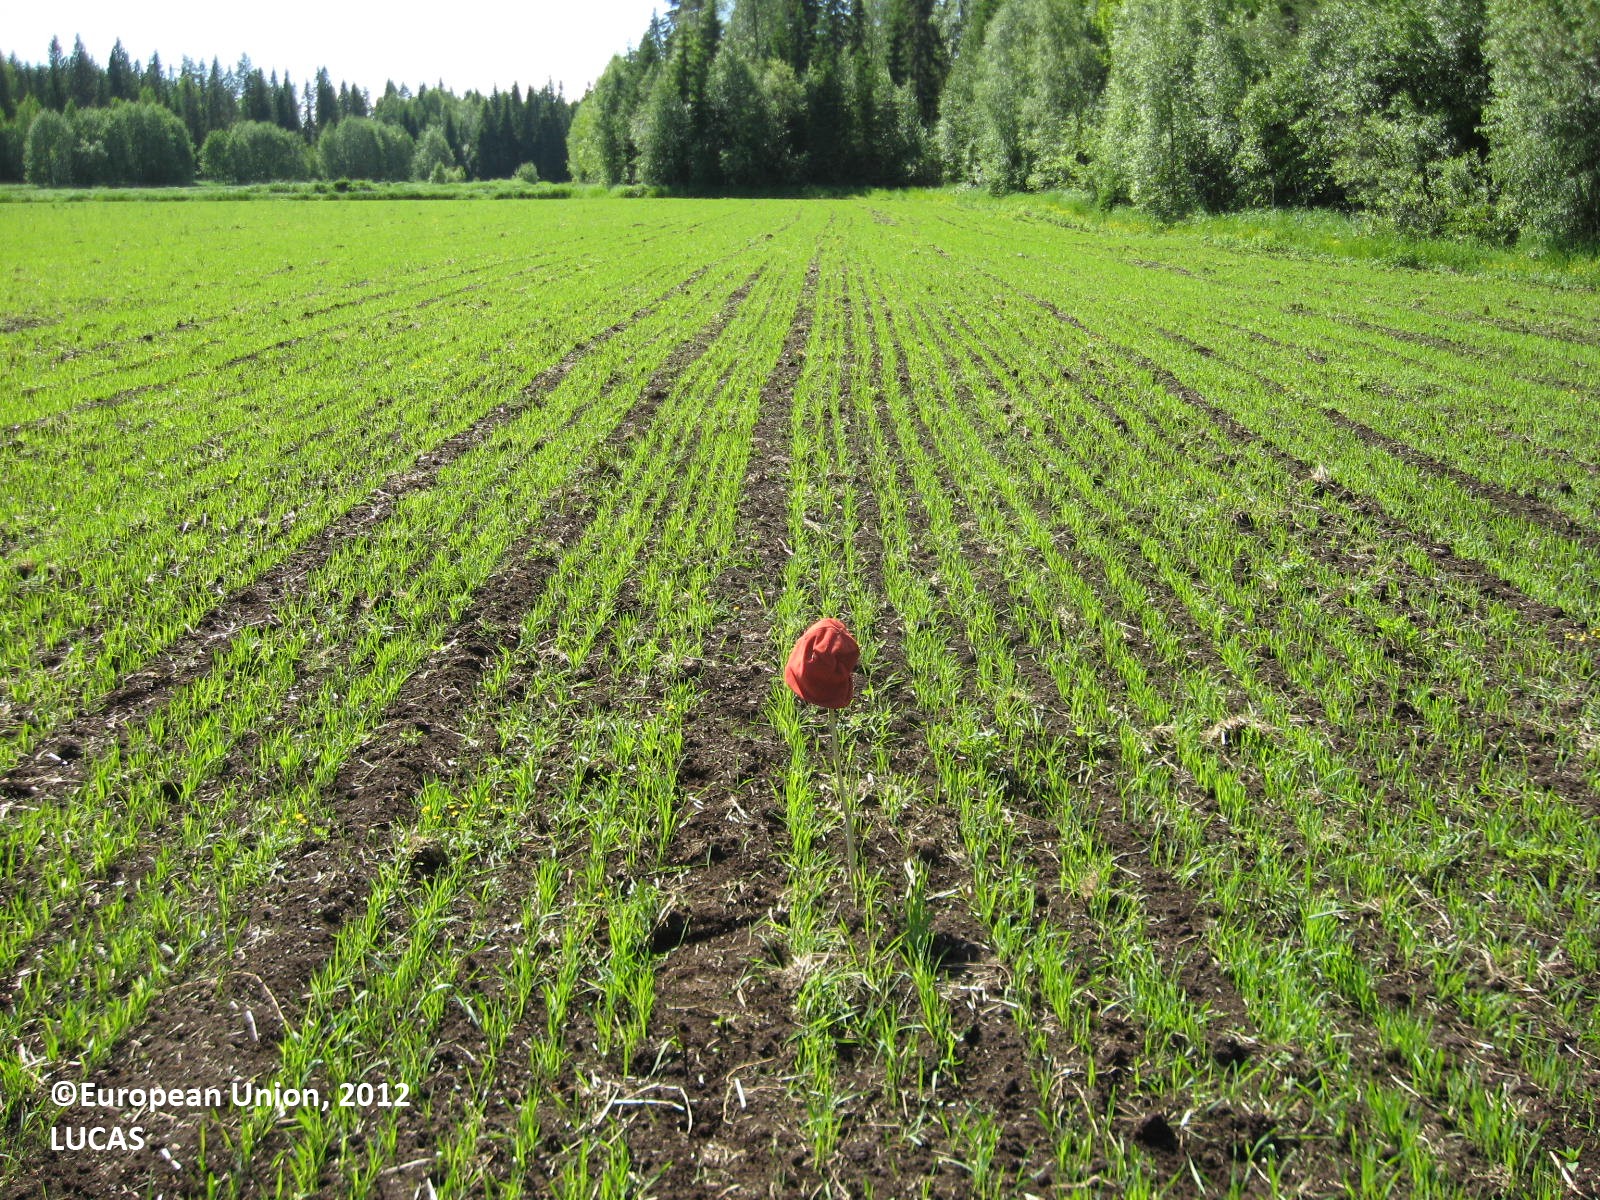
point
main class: Cropland
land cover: Oats
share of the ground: 50 - 75 %
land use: Agriculture (excluding fallow land and kitchen gardens)
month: June
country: FI
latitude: 62.8374
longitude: 21.8451
